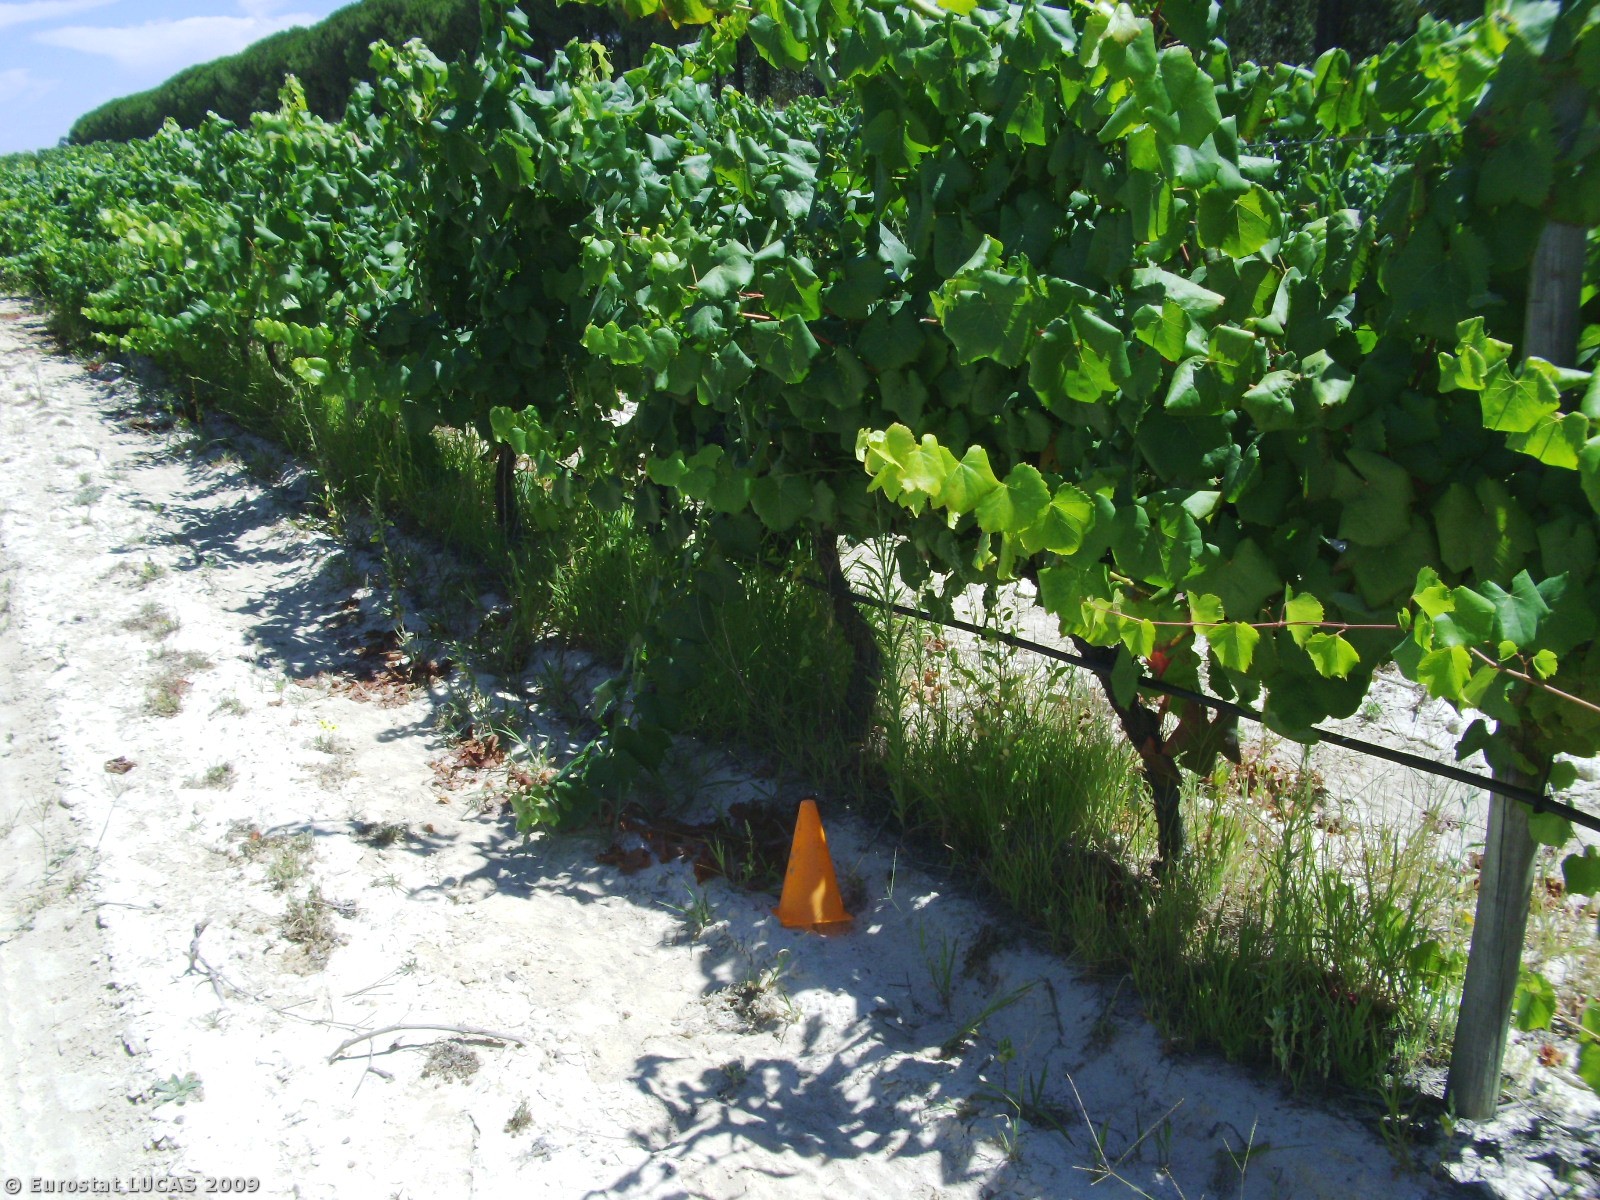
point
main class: Cropland
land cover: Vineyards
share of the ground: 25 - 50 %
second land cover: Bare land
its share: 50 - 75 %
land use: Agriculture (excluding fallow land and kitchen gardens)
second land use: Fallow land
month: August
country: PT
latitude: 38.6614
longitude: -8.6664
